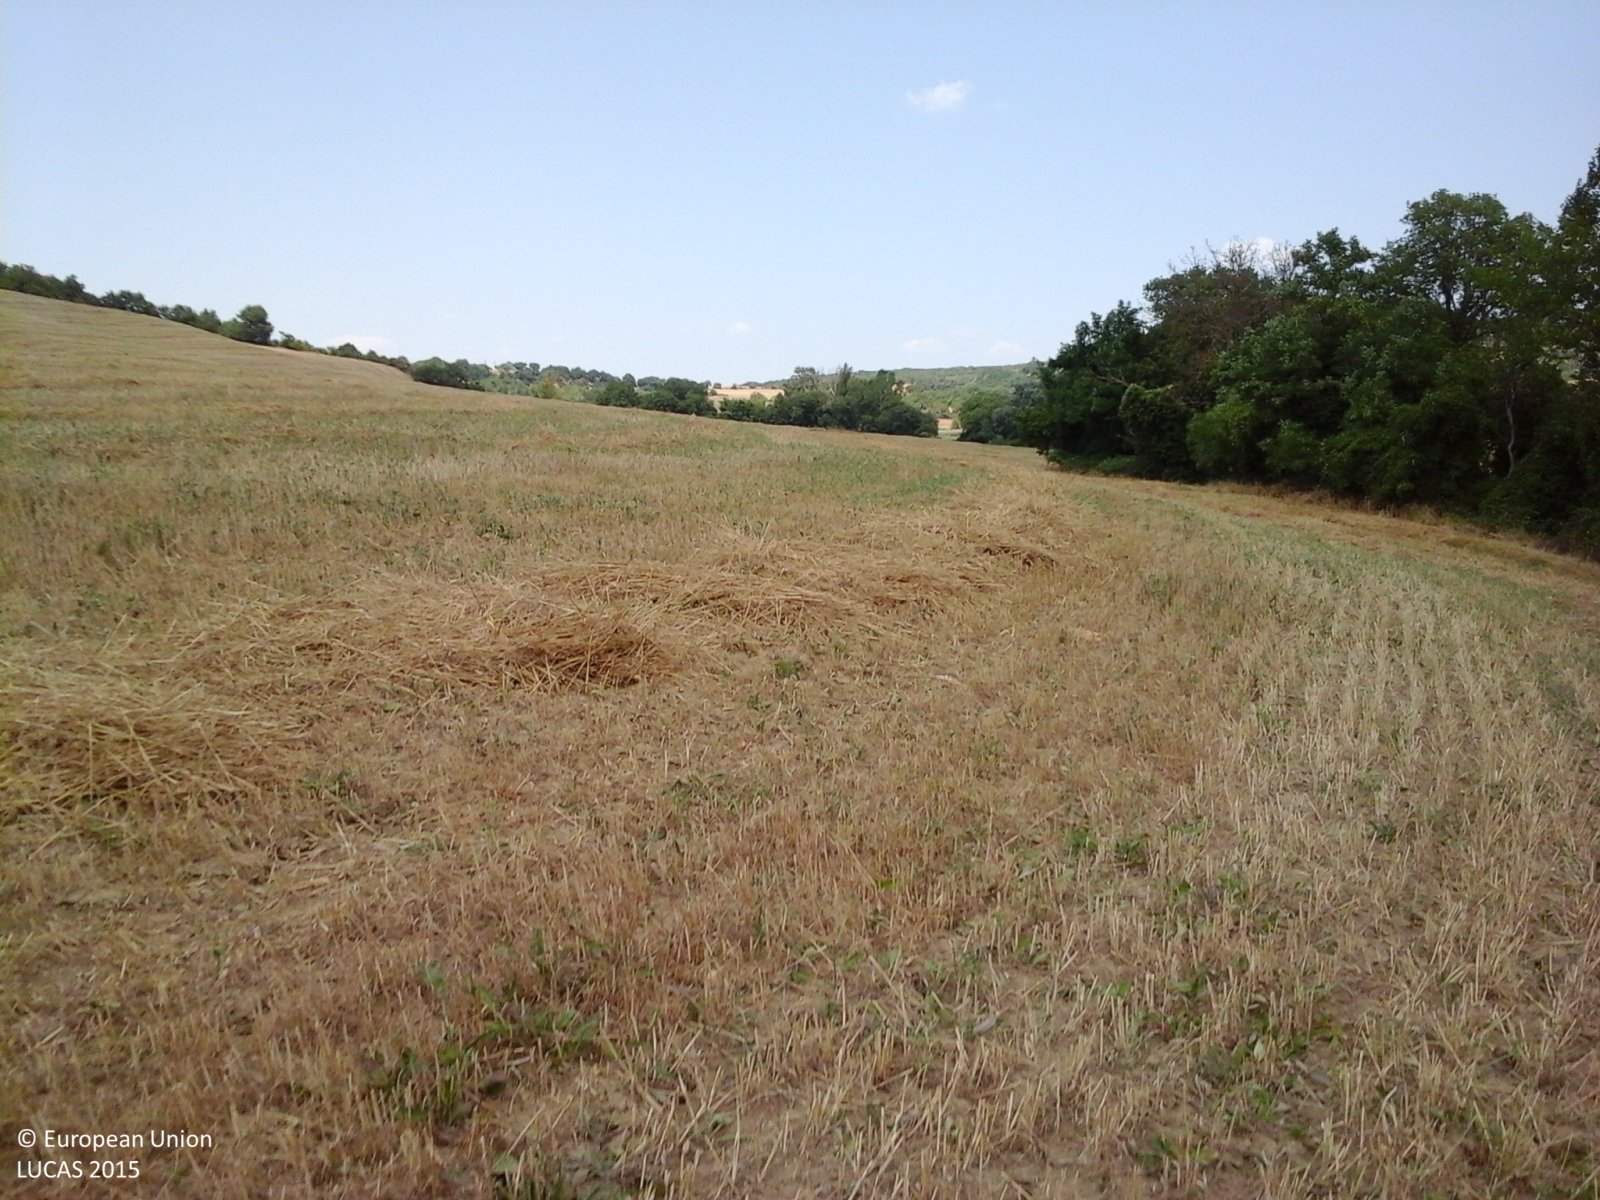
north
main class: Cropland
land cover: Durum wheat
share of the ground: > 75 %
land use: Agriculture (excluding fallow land and kitchen gardens)
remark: Harvested field
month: July
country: IT
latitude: 43.0740
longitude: 11.6530
